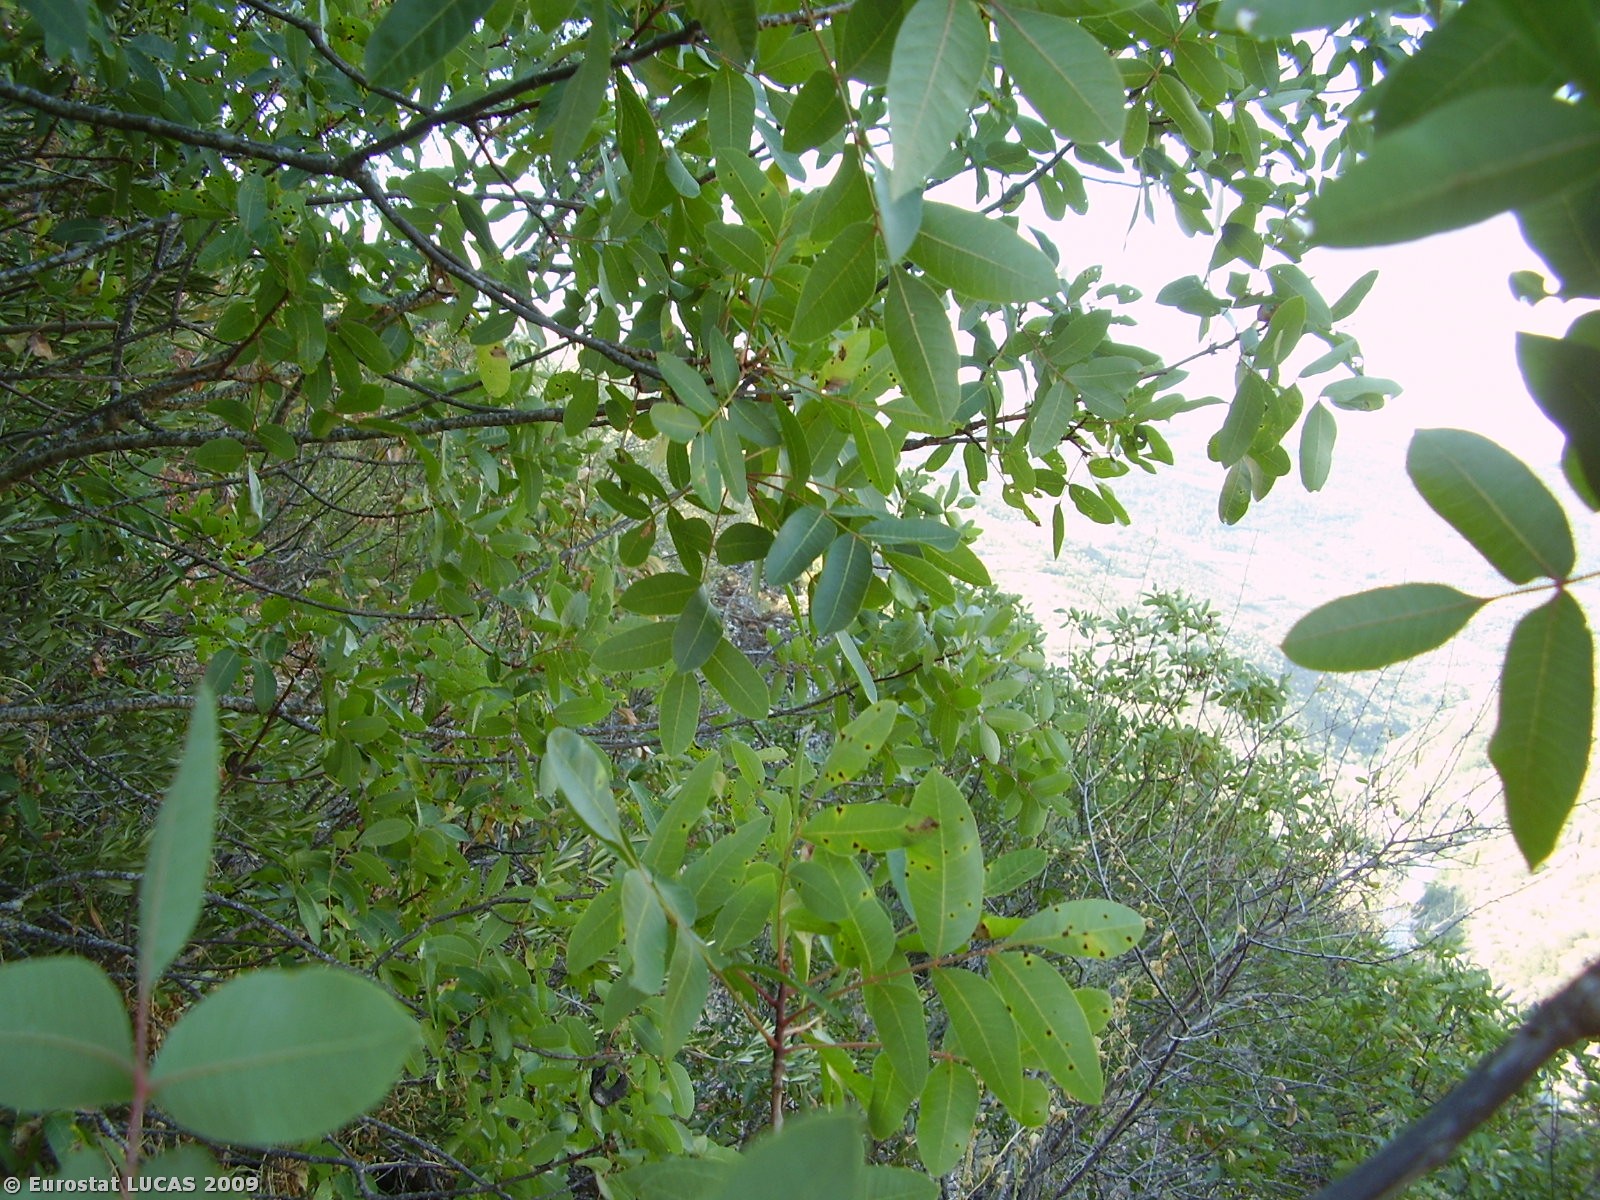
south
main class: Shrubland
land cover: Shrubland with sparse tree cover
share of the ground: > 75 %
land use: Fallow land
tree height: > 5 m
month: August
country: PT
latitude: 41.3271
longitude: -6.8226
